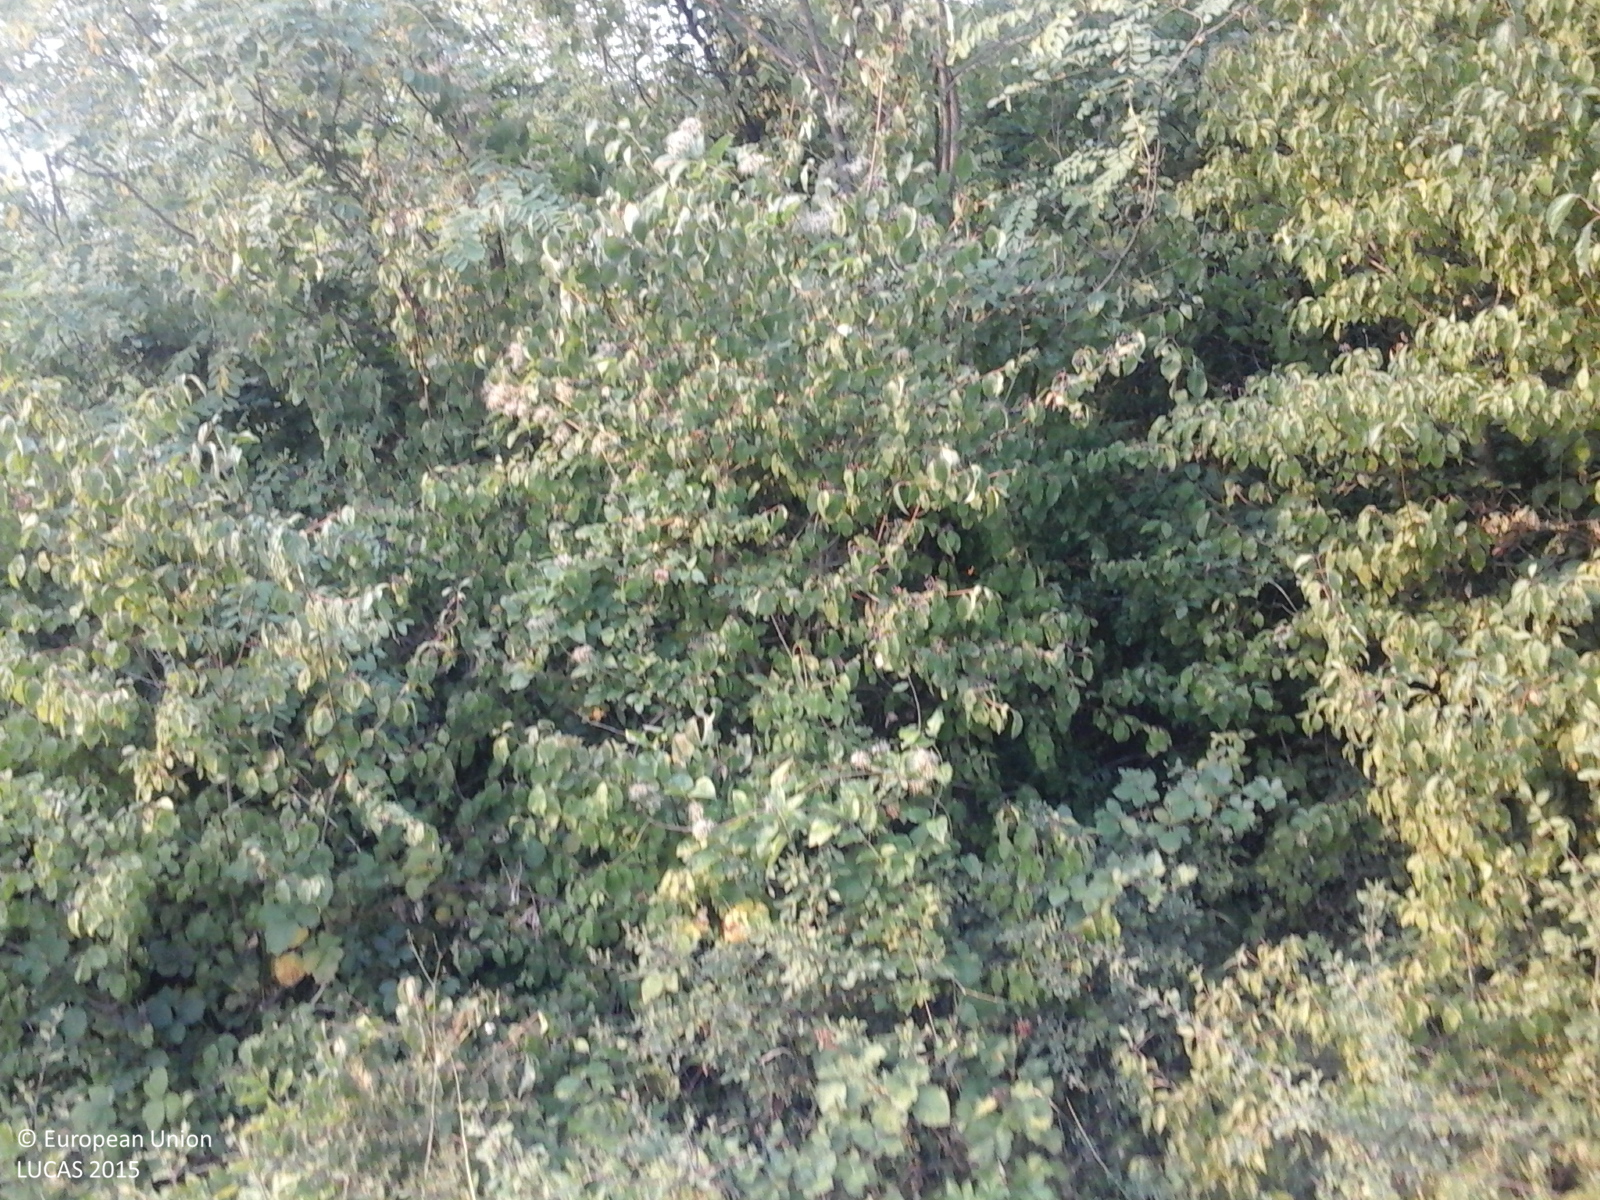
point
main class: Woodland
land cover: Broadleaved woodland
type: mesophytic deciduous forest
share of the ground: > 75 %
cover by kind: broadleaved forest trees 100 %
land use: Forestry
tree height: > 5 m
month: August
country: RO
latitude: 44.5655
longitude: 23.0278
